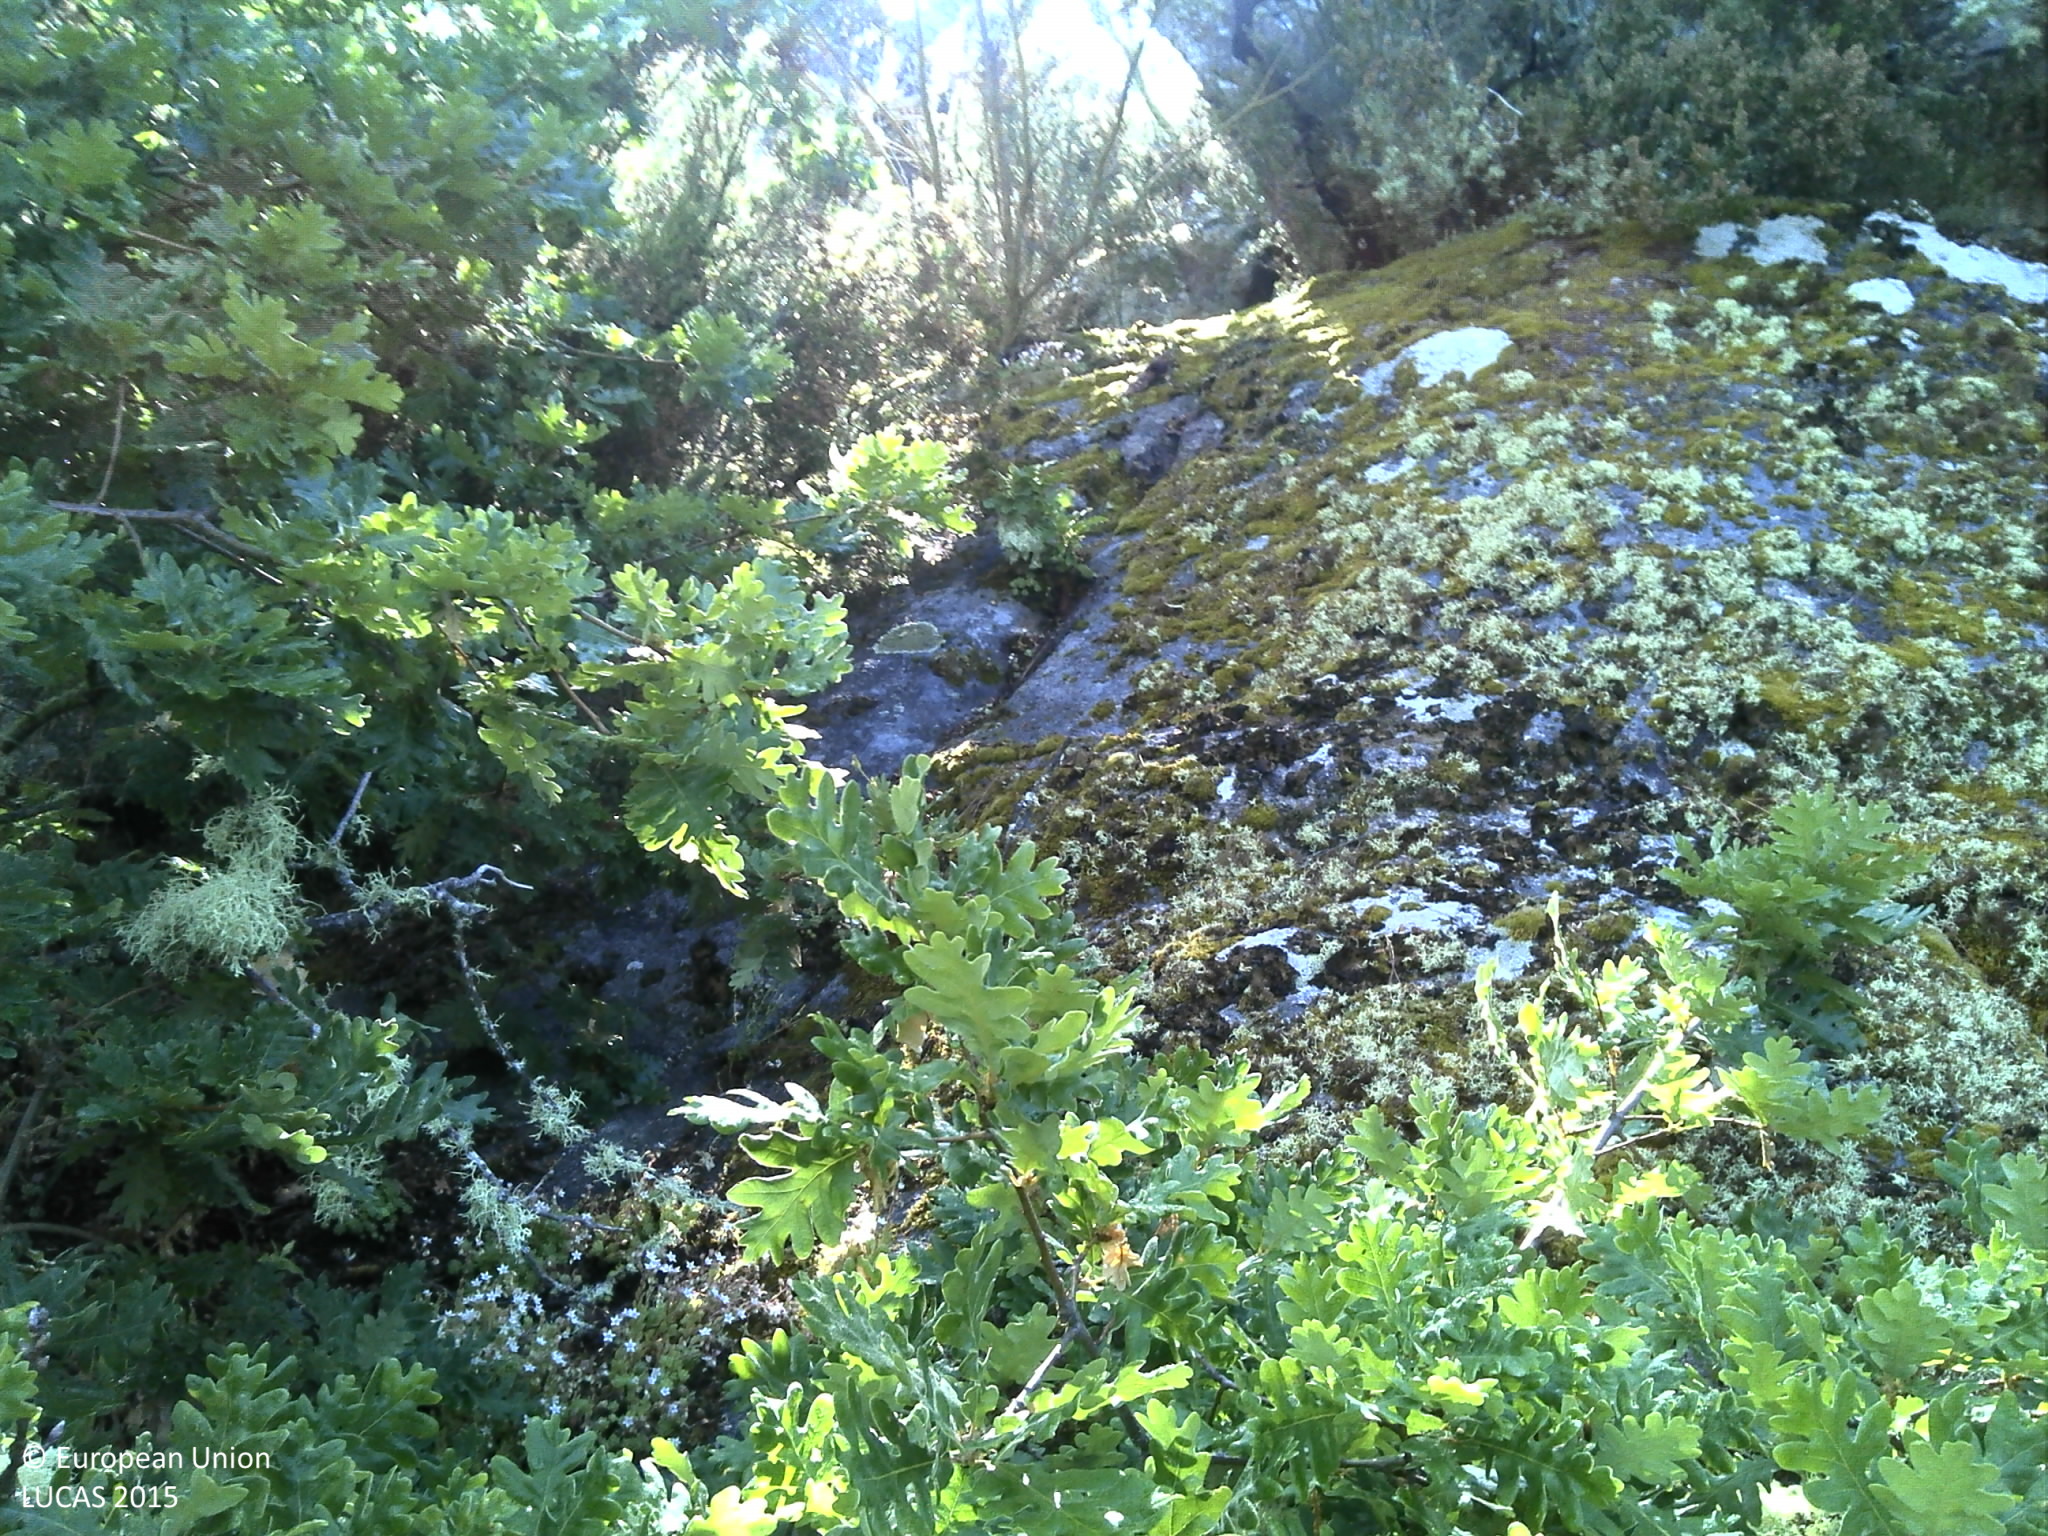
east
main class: Woodland
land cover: Broadleaved woodland
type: acidophilous oak and oak-birch forest
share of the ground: 10 - 25 %
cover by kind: consolidated bare surface 50 %, shrubs 20 %, broadleaved forest trees 15 %, herbaceous plants 10 %, unconsolidated bare surface 5 %
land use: Semi-natural and natural areas not in use
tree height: > 5 m
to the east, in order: Broadleaved woodland; Shrubland without tree cover; Broadleaved woodland; Rock outcrops; Broadleaved woodland; Nuts trees; Dry stone walls; Broadleaved woodland; Shrubland with sparse tree cover; Grassland without tree/shrub cover
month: June
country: PT
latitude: 41.0827
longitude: -7.5851
